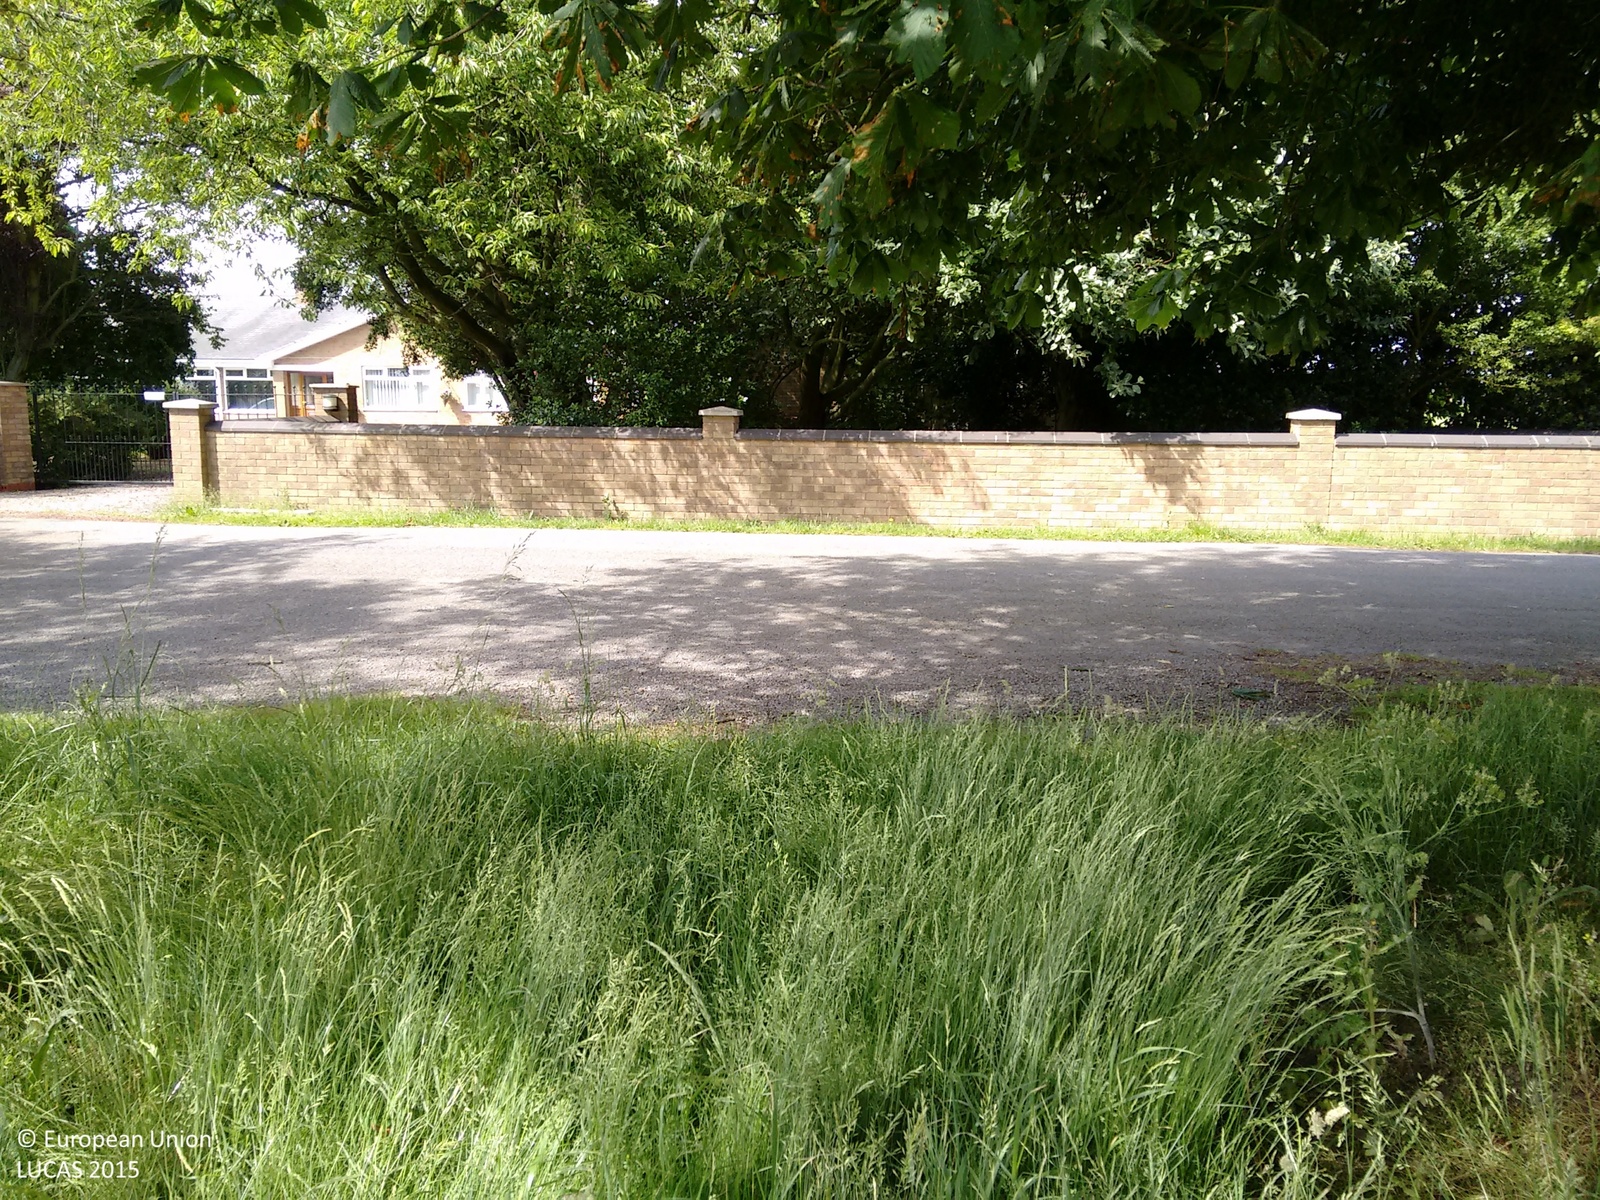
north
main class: Cropland
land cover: Maize
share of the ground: 25 - 50 %
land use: Agriculture (excluding fallow land and kitchen gardens)
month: June
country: GB
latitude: 52.9823
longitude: -0.0568
